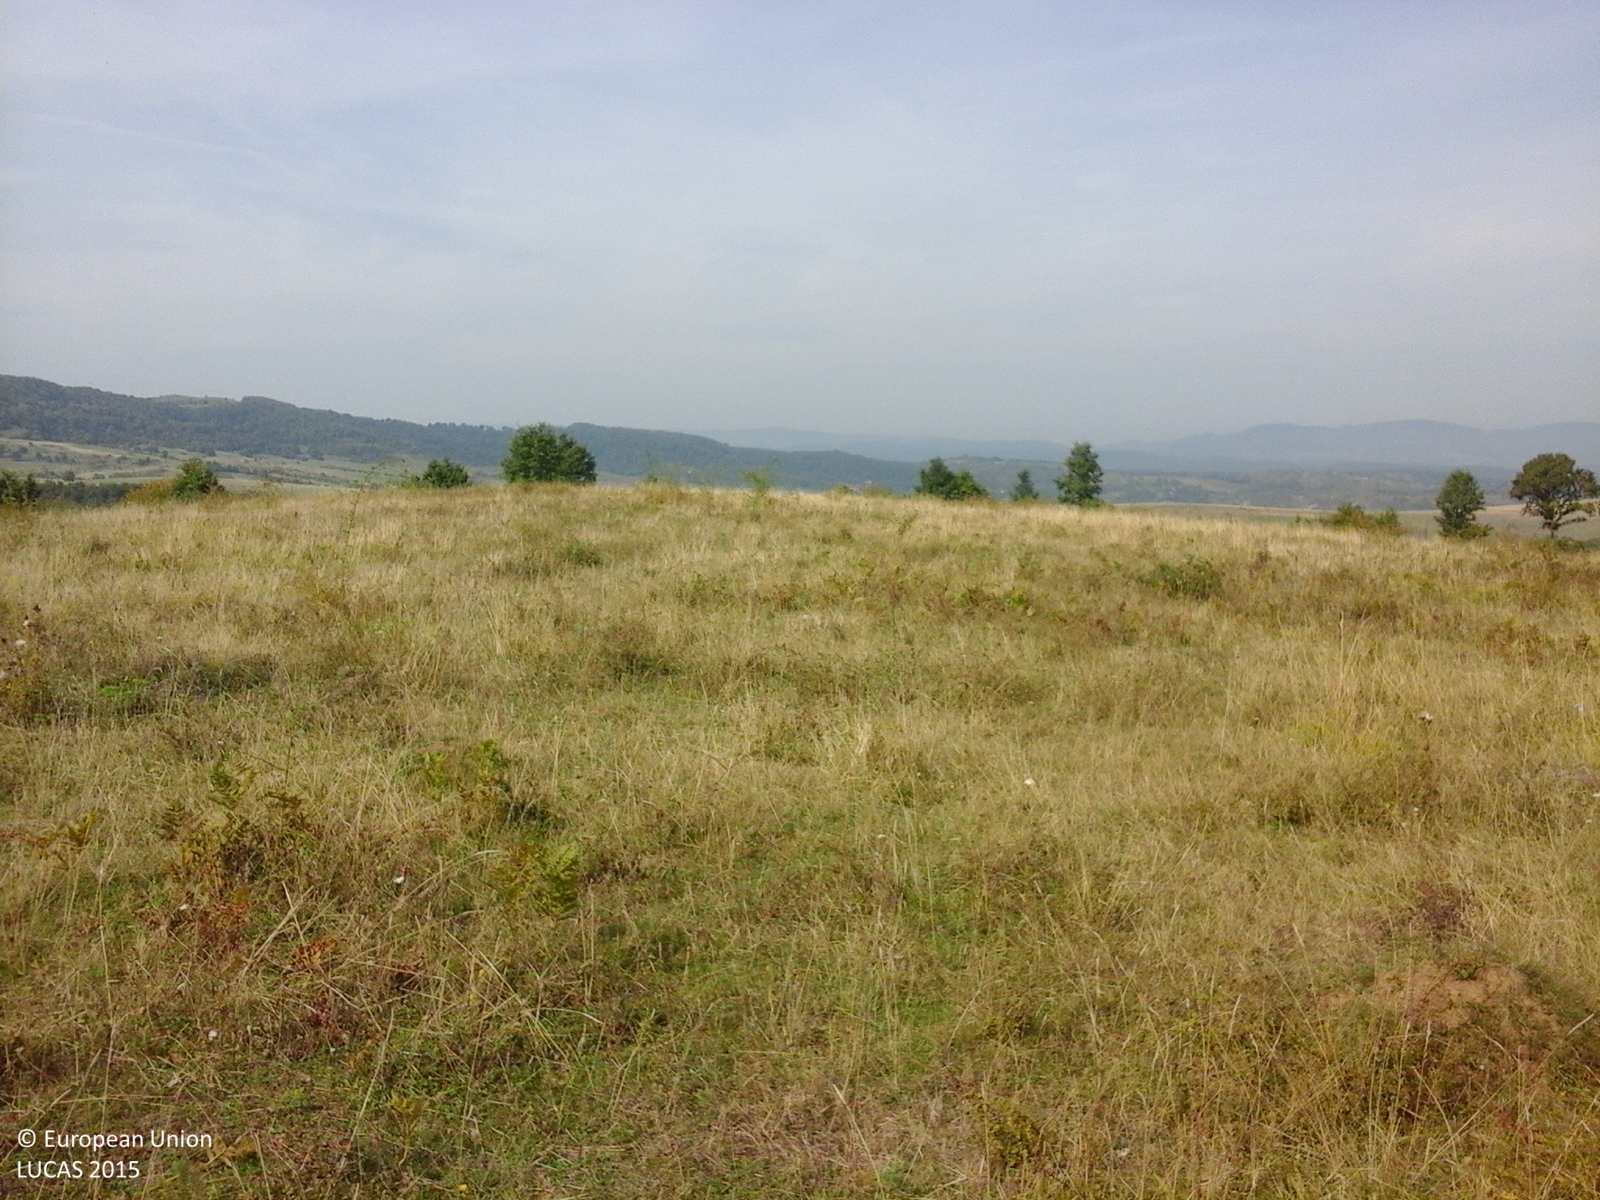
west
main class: Grassland
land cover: Grassland with sparse tree/shrub cover
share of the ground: > 75 %
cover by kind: herbaceous plants 85 %, shrubs 10 %, broadleaved forest trees 5 %
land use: Fallow land
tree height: < 5 m
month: September
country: RO
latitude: 46.8736
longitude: 23.0914
